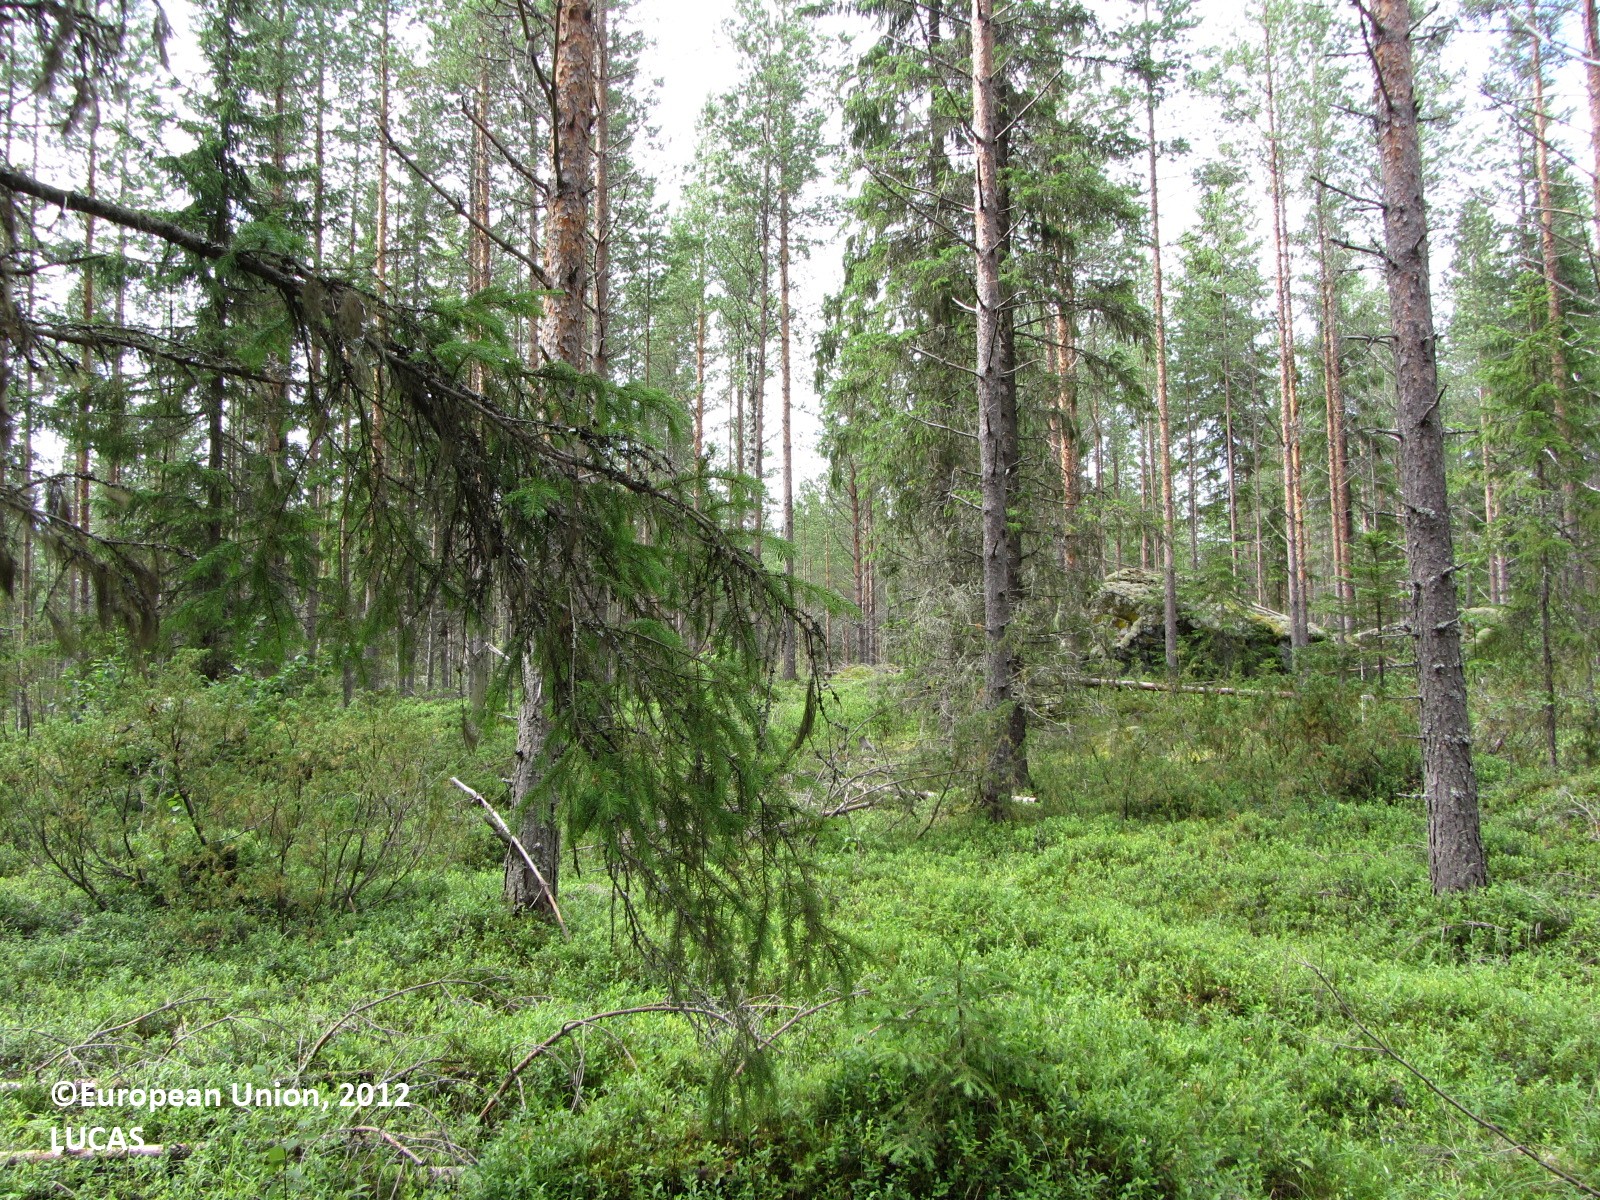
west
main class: Woodland
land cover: Other coniferous woodland
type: boreal forest
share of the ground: > 75 %
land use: Forestry
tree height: > 5 m
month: July
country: FI
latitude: 63.6945
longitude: 25.4078
